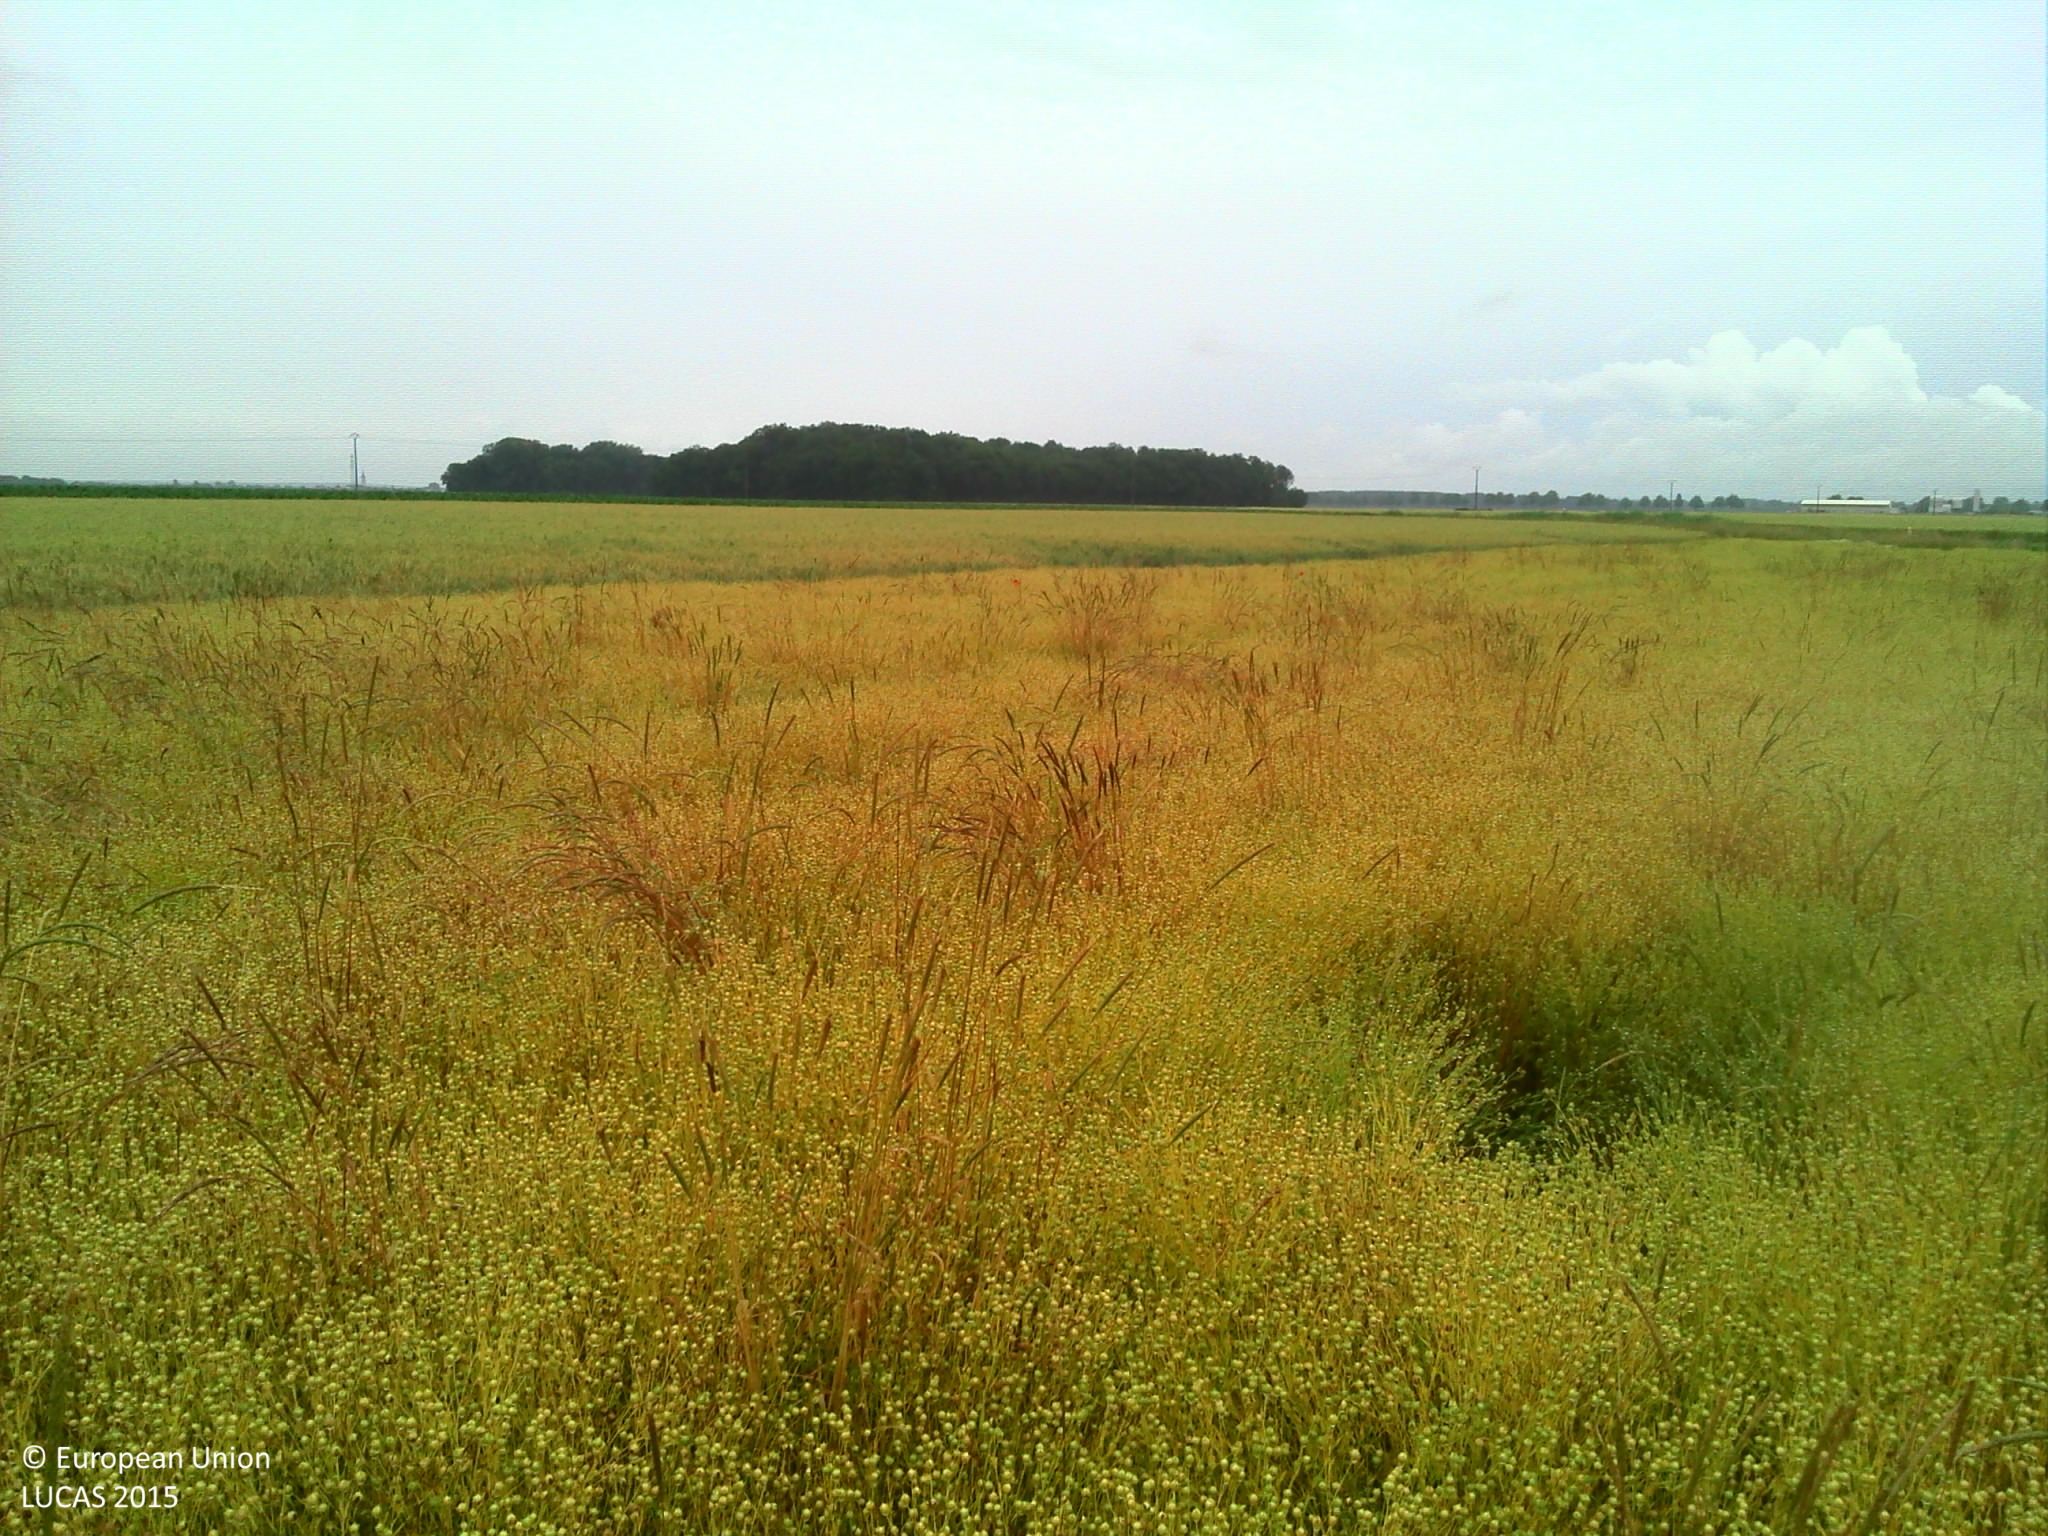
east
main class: Cropland
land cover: Other fibre and oleaginous crops
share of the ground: > 75 %
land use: Agriculture (excluding fallow land and kitchen gardens)
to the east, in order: Other fibre and oleaginous crops; Common wheat; Maize
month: June
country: FR
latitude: 47.0260
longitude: 5.3569
